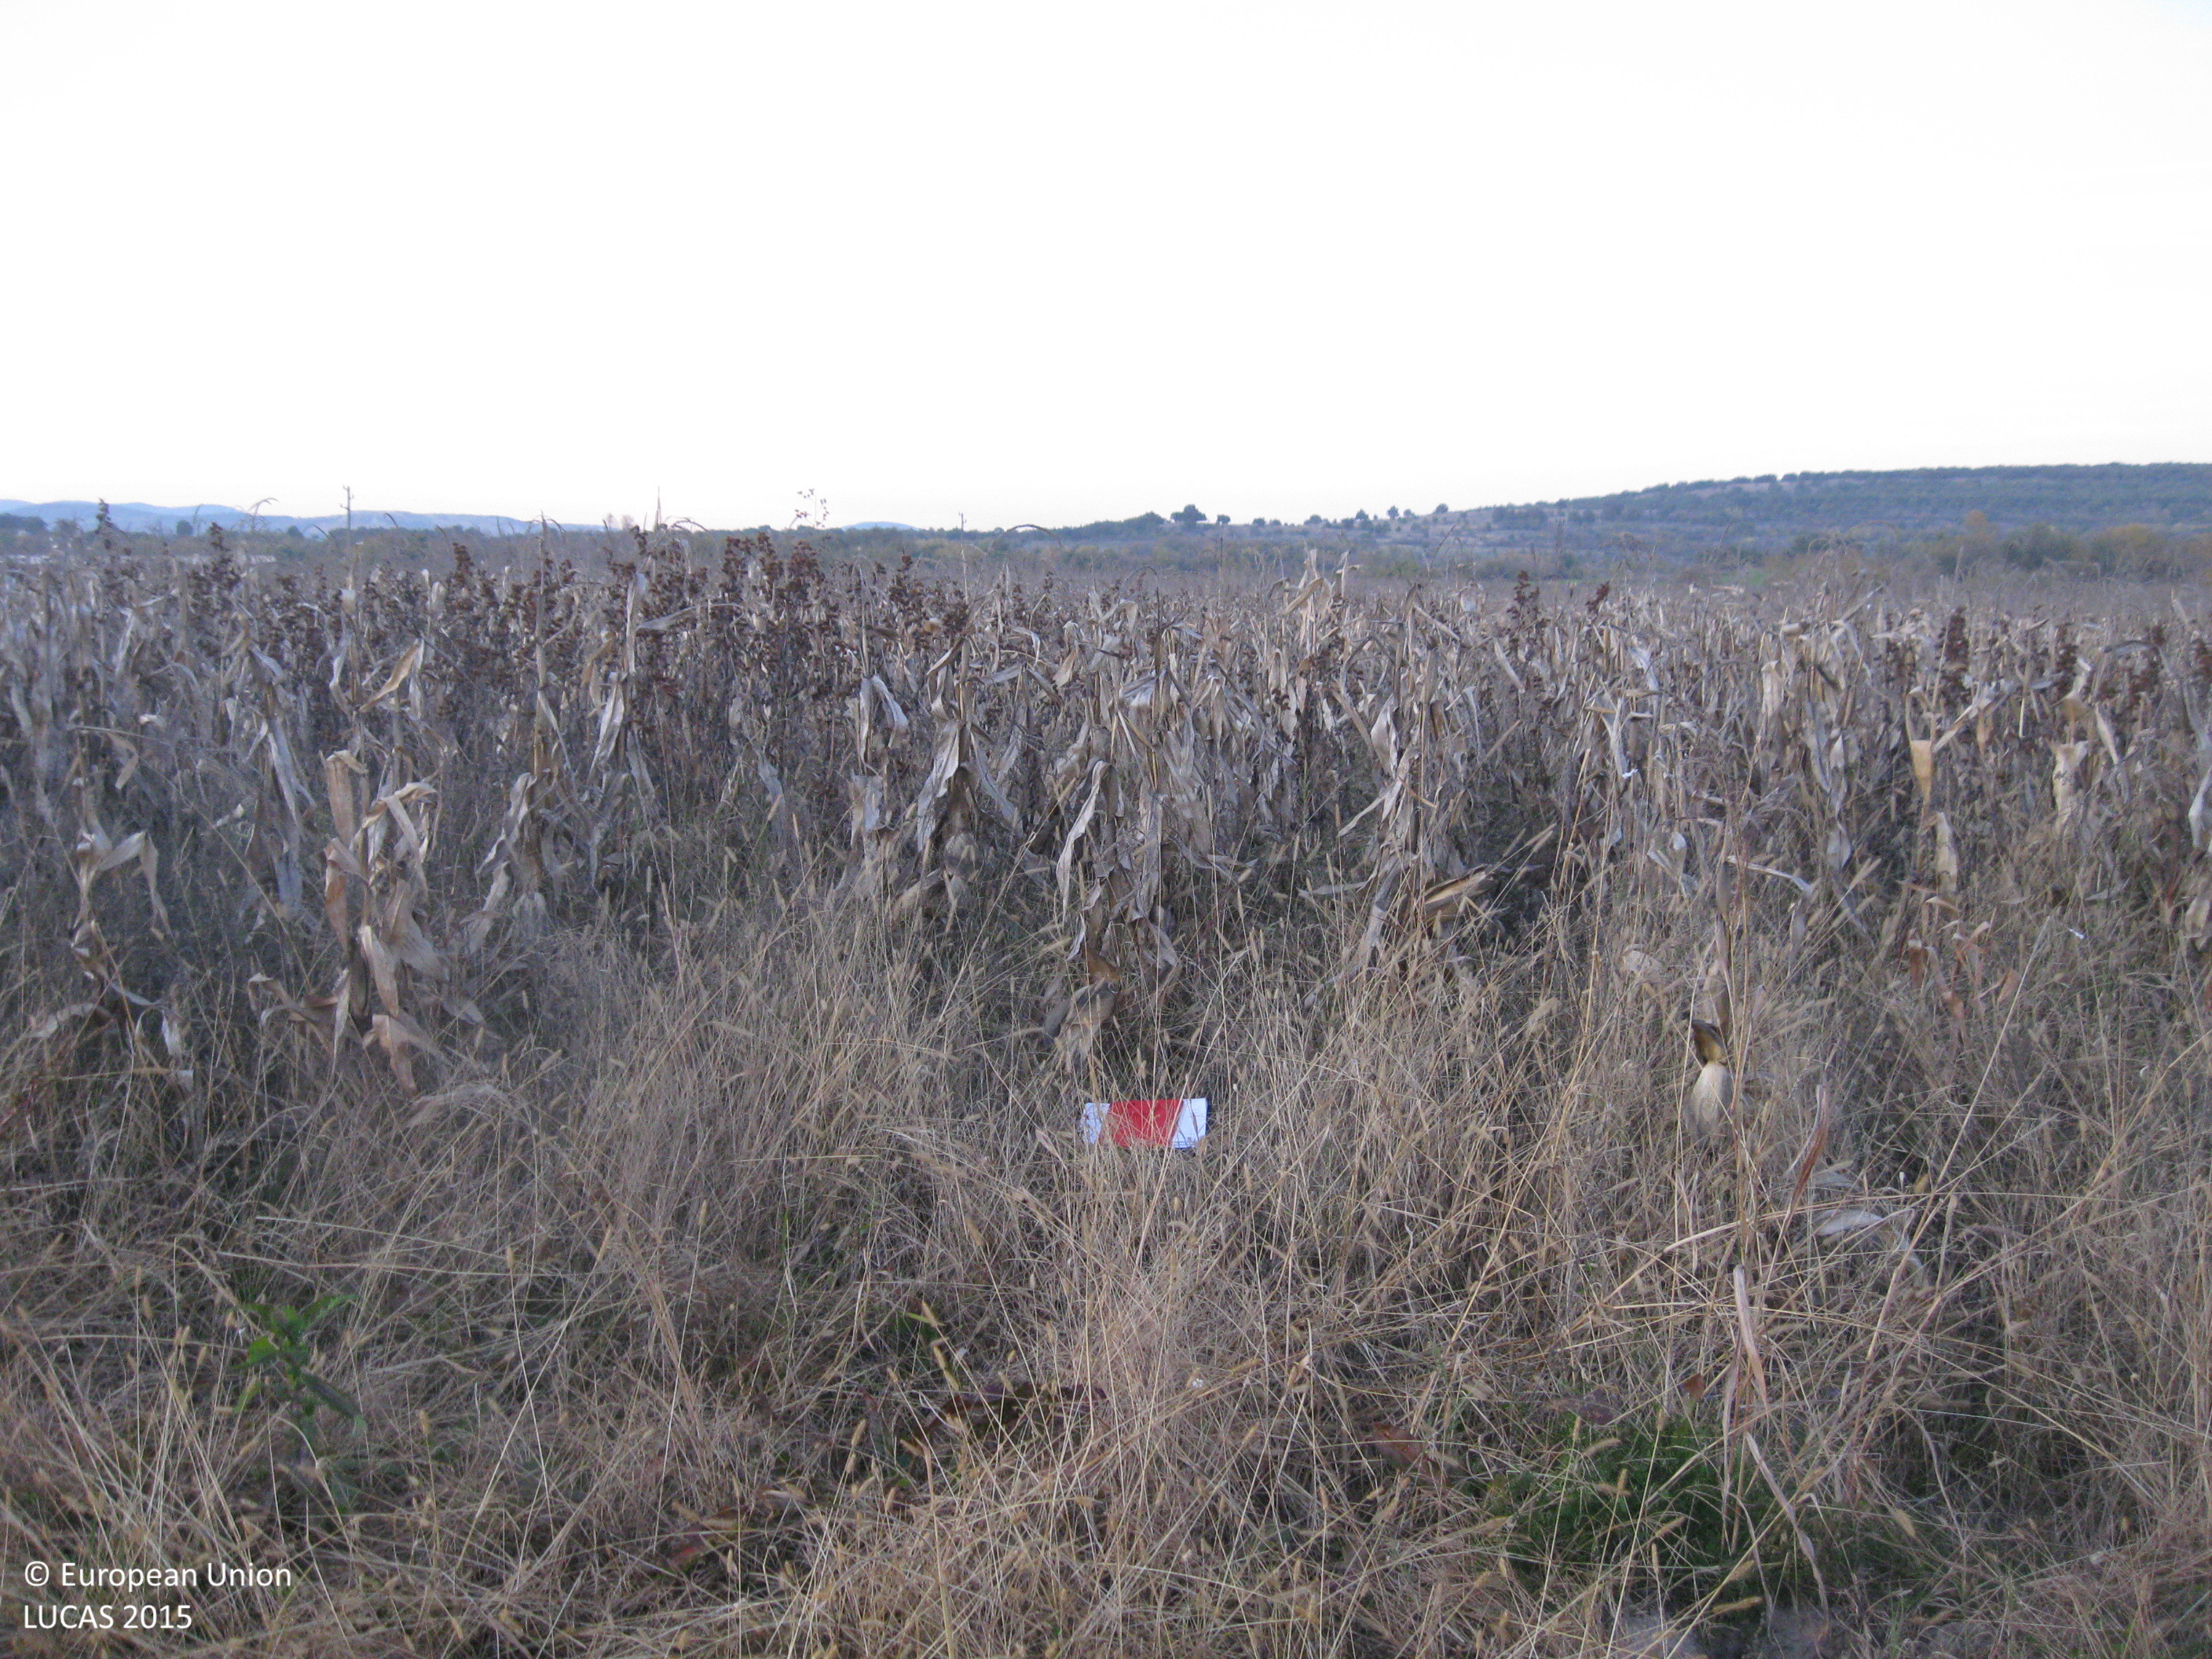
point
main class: Cropland
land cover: Maize
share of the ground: > 75 %
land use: Agriculture (excluding fallow land and kitchen gardens)
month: November
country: BG
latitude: 42.3000
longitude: 24.2487
